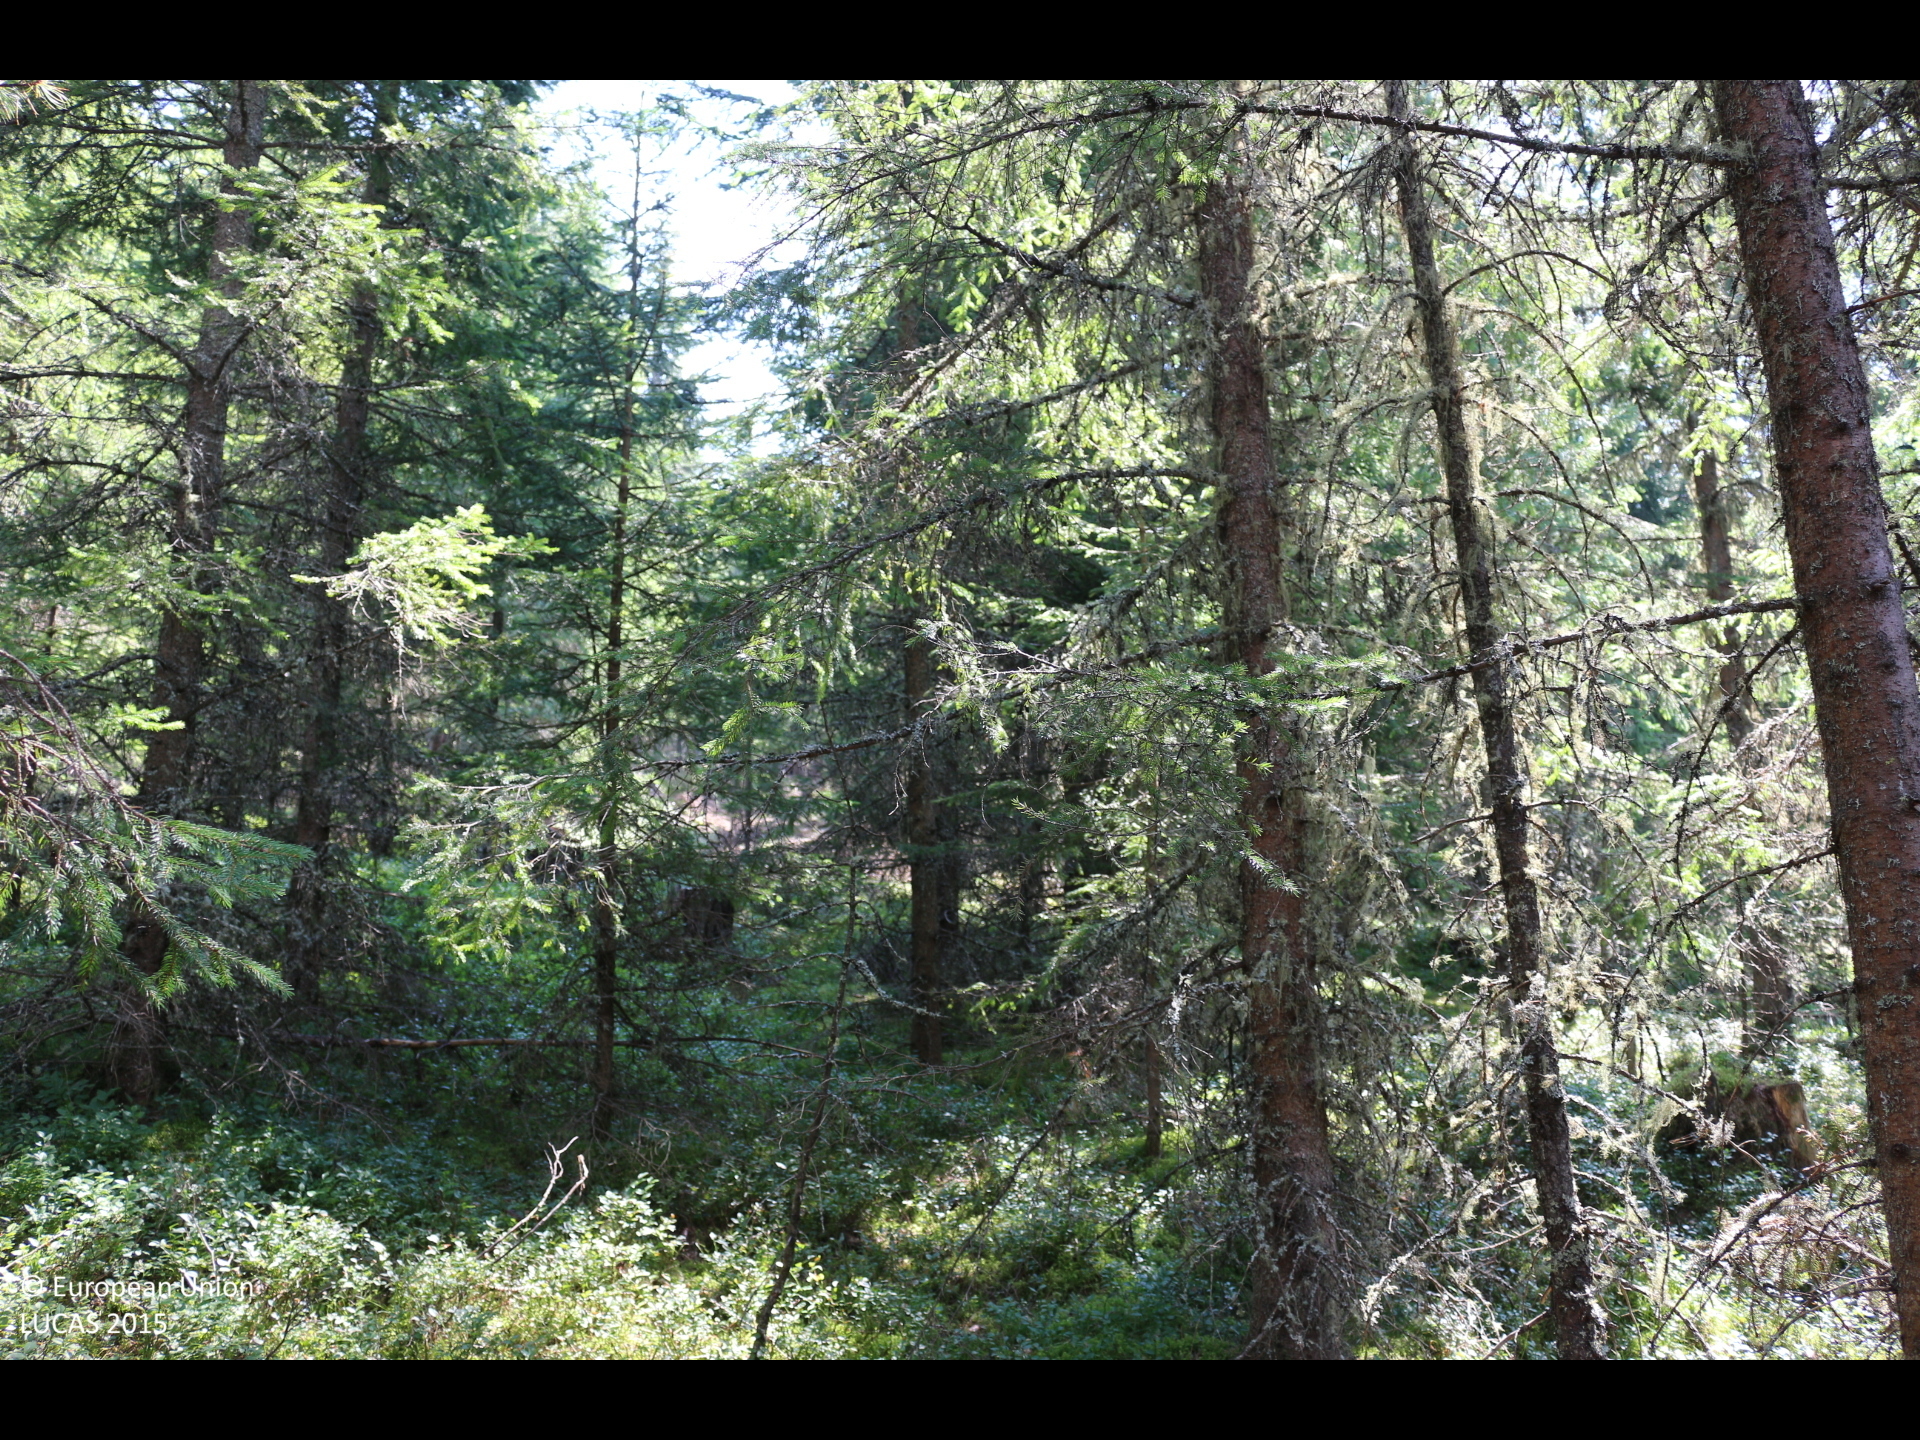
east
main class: Woodland
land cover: Spruce dominated coniferous woodland
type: alpine coniferous forest
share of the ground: > 75 %
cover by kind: coniferous forest trees 90 %, herbaceous plants 10 %
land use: Forestry
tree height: > 5 m
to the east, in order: Spruce dominated coniferous woodland; Tracks; Spruce dominated coniferous woodland; Tracks; Grassland without tree/shrub cover; Spruce dominated coniferous woodland; Tracks; Spruce dominated coniferous woodland
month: August
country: AT
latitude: 46.8715
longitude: 13.9992
